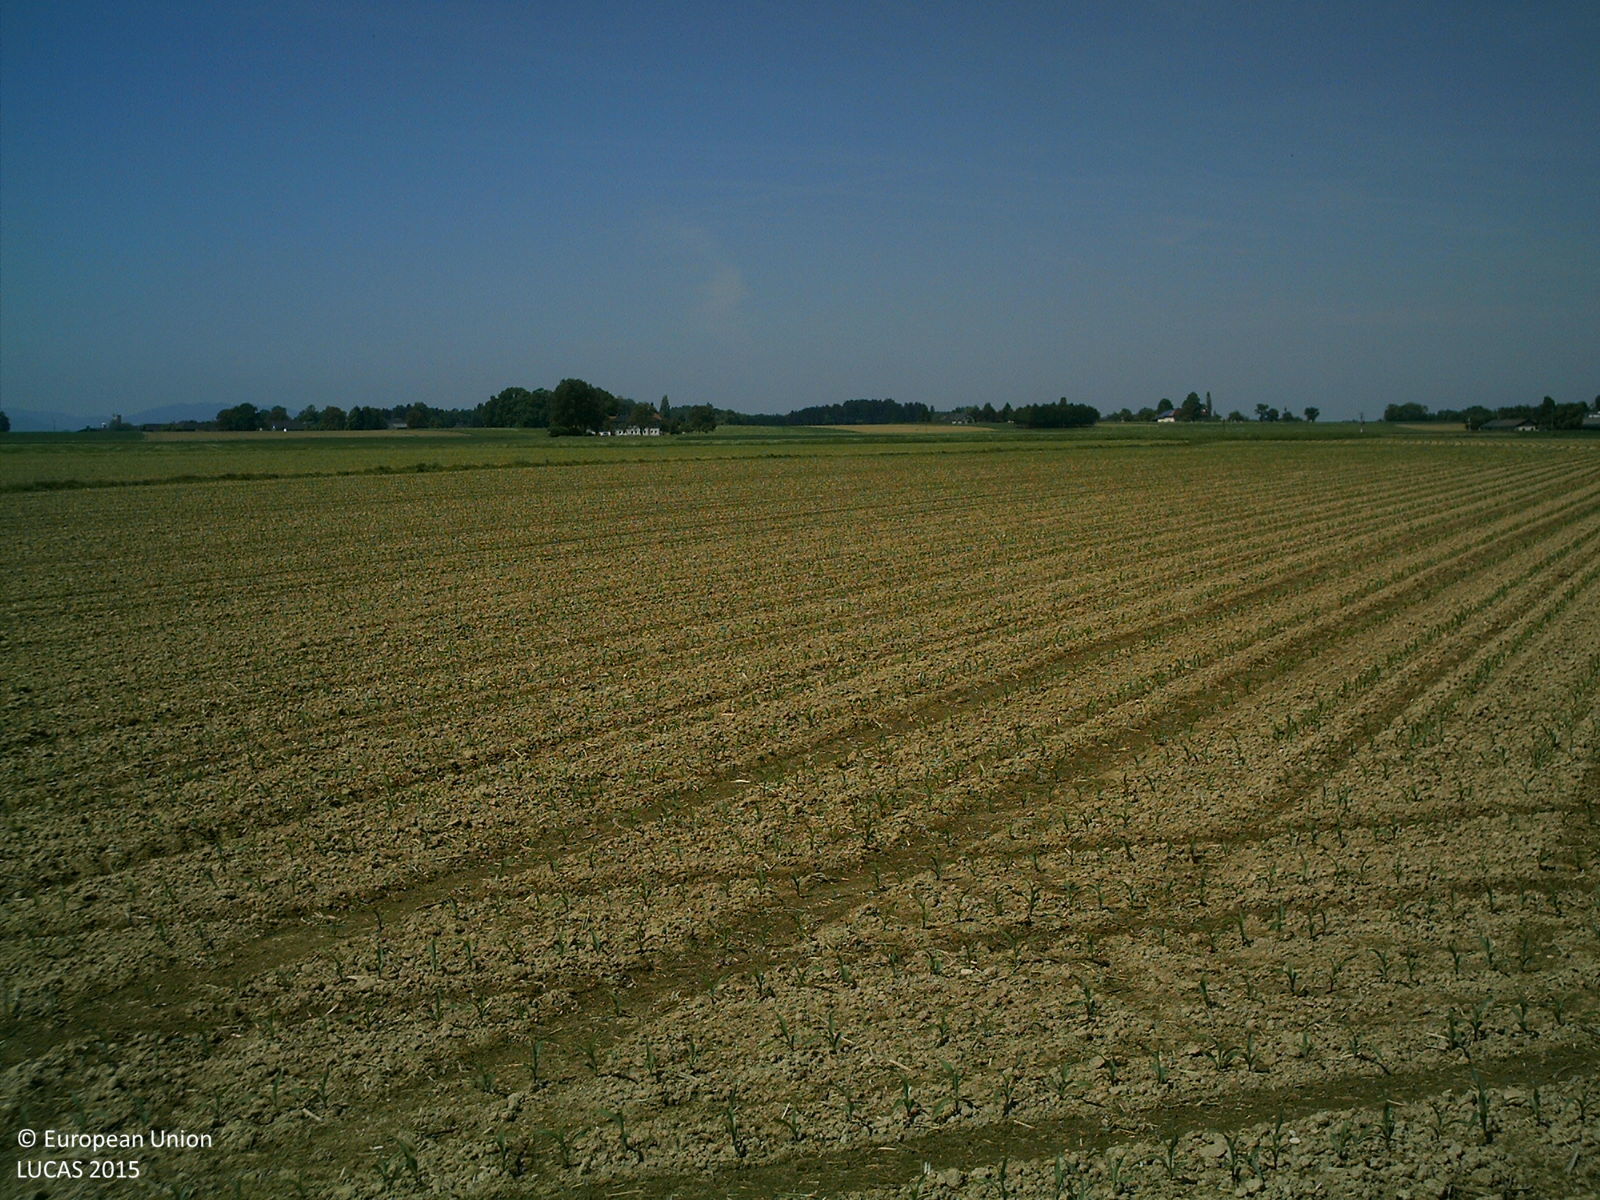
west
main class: Cropland
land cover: Maize
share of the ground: < 10 %
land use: Agriculture (excluding fallow land and kitchen gardens)
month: May
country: AT
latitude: 47.9886
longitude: 14.0059
